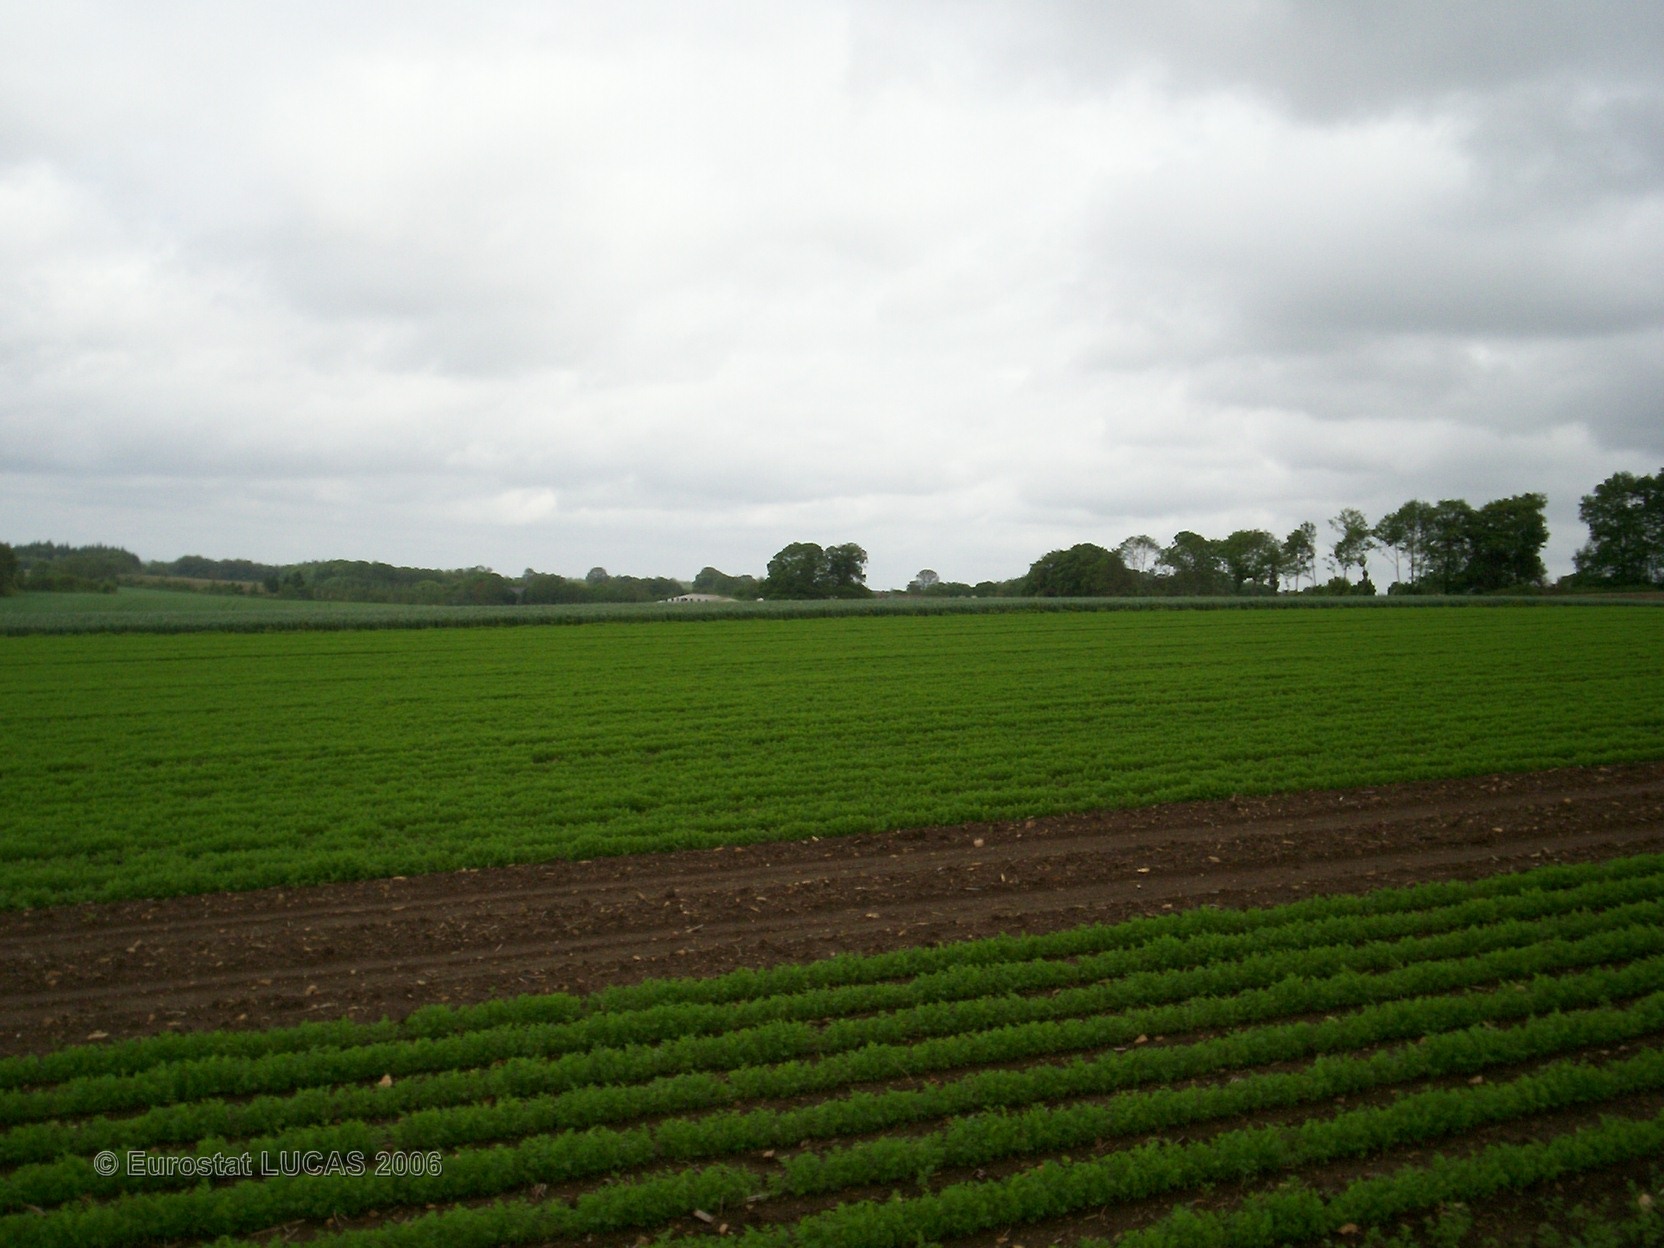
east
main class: Cropland
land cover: Other fresh vegetables
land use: Agriculture (excluding fallow land and kitchen gardens)
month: May
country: FR
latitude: 47.9079
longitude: -3.5768
